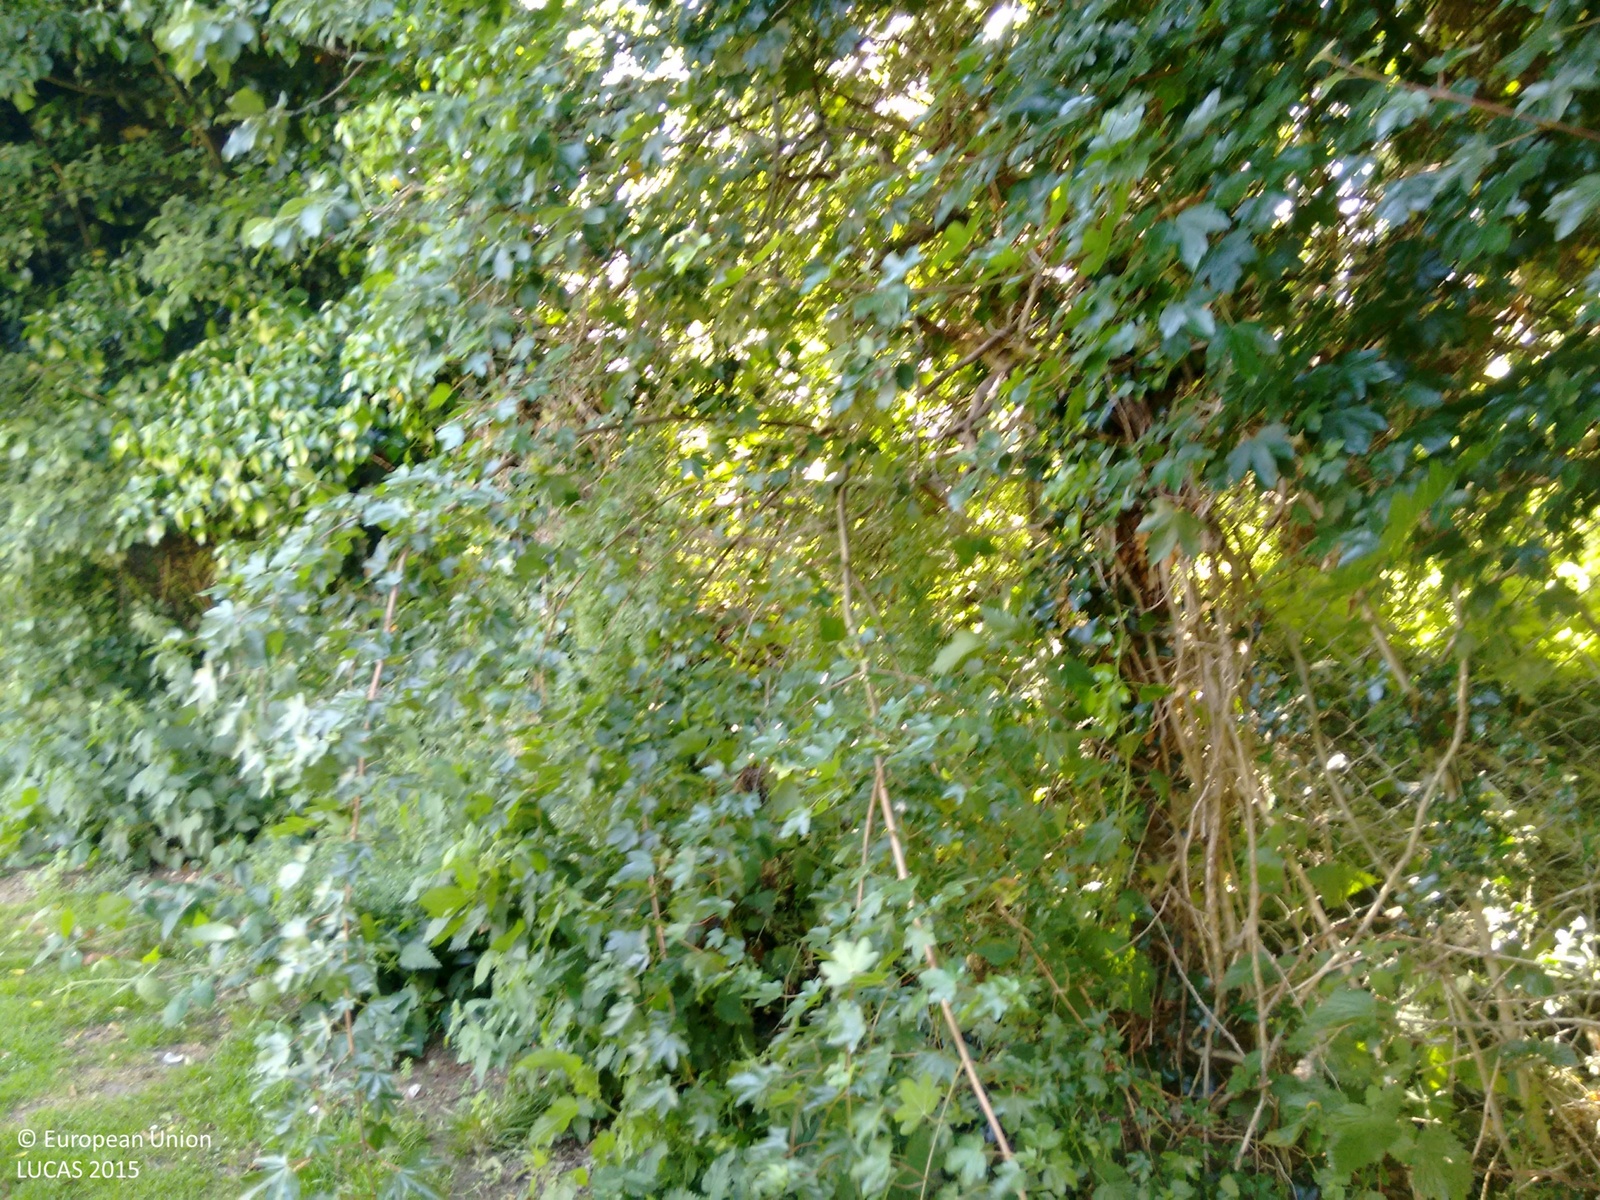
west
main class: Woodland
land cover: Broadleaved woodland
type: mesophytic deciduous forest
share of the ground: > 75 %
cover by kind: broadleaved forest trees 60 %, shrubs 40 %
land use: Semi-natural and natural areas not in use
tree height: > 5 m
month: June
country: GB
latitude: 50.8572
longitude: 0.5255
